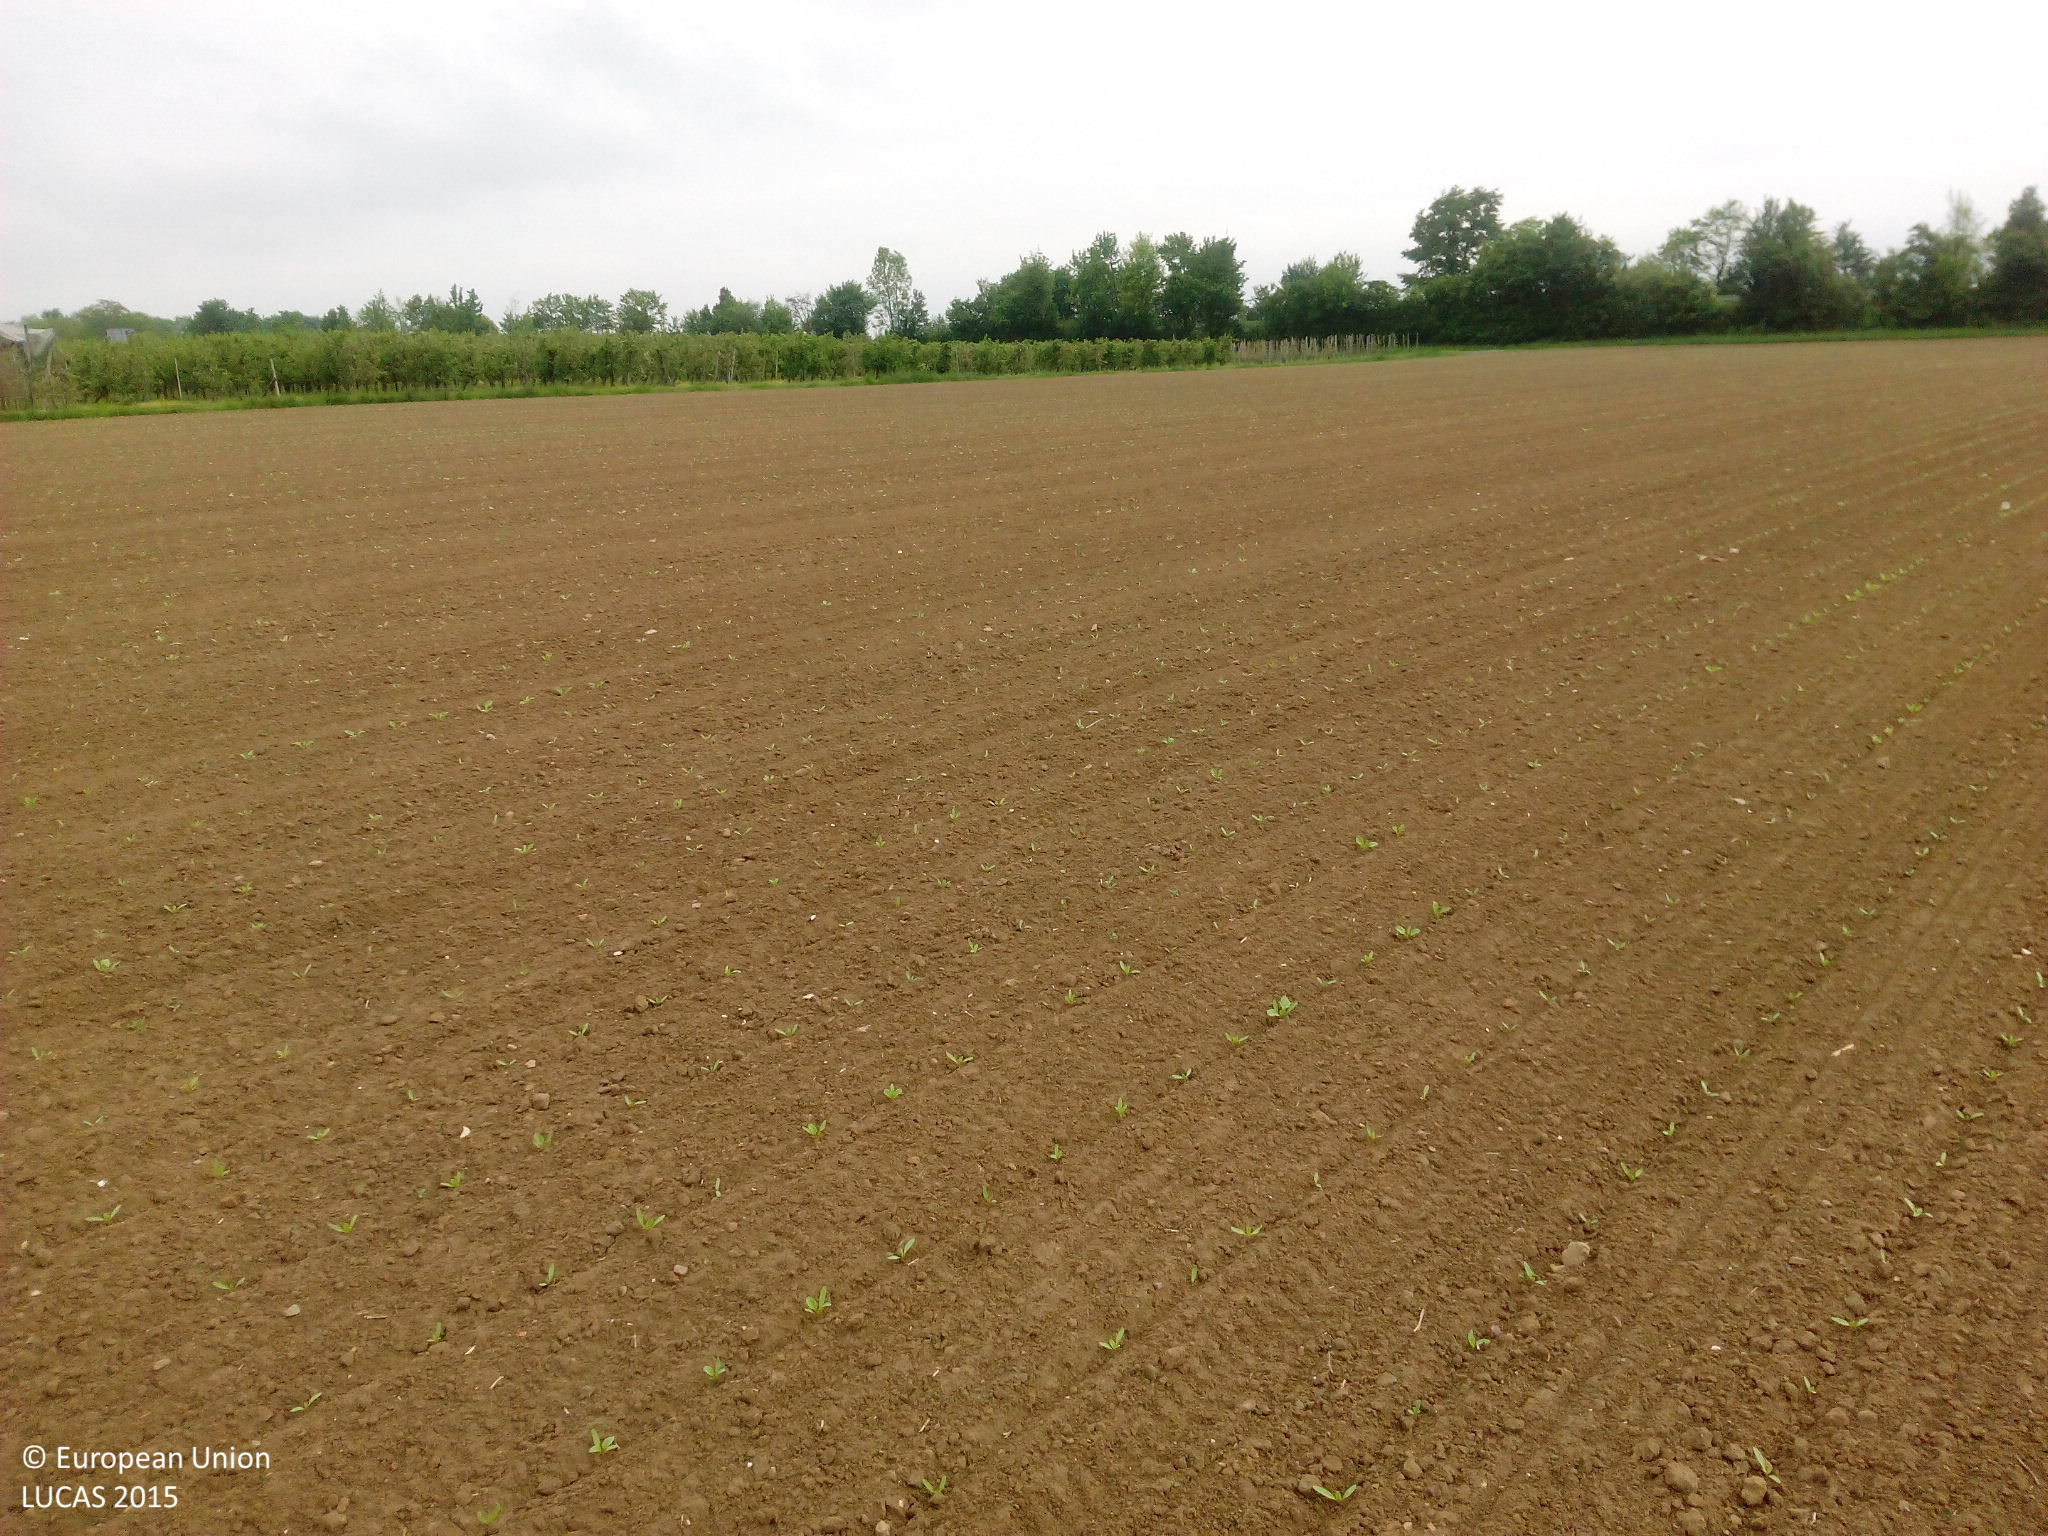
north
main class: Cropland
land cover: Sugar beet
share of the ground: < 10 %
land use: Agriculture (excluding fallow land and kitchen gardens)
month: May
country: DE
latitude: 50.5951
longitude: 7.0193
